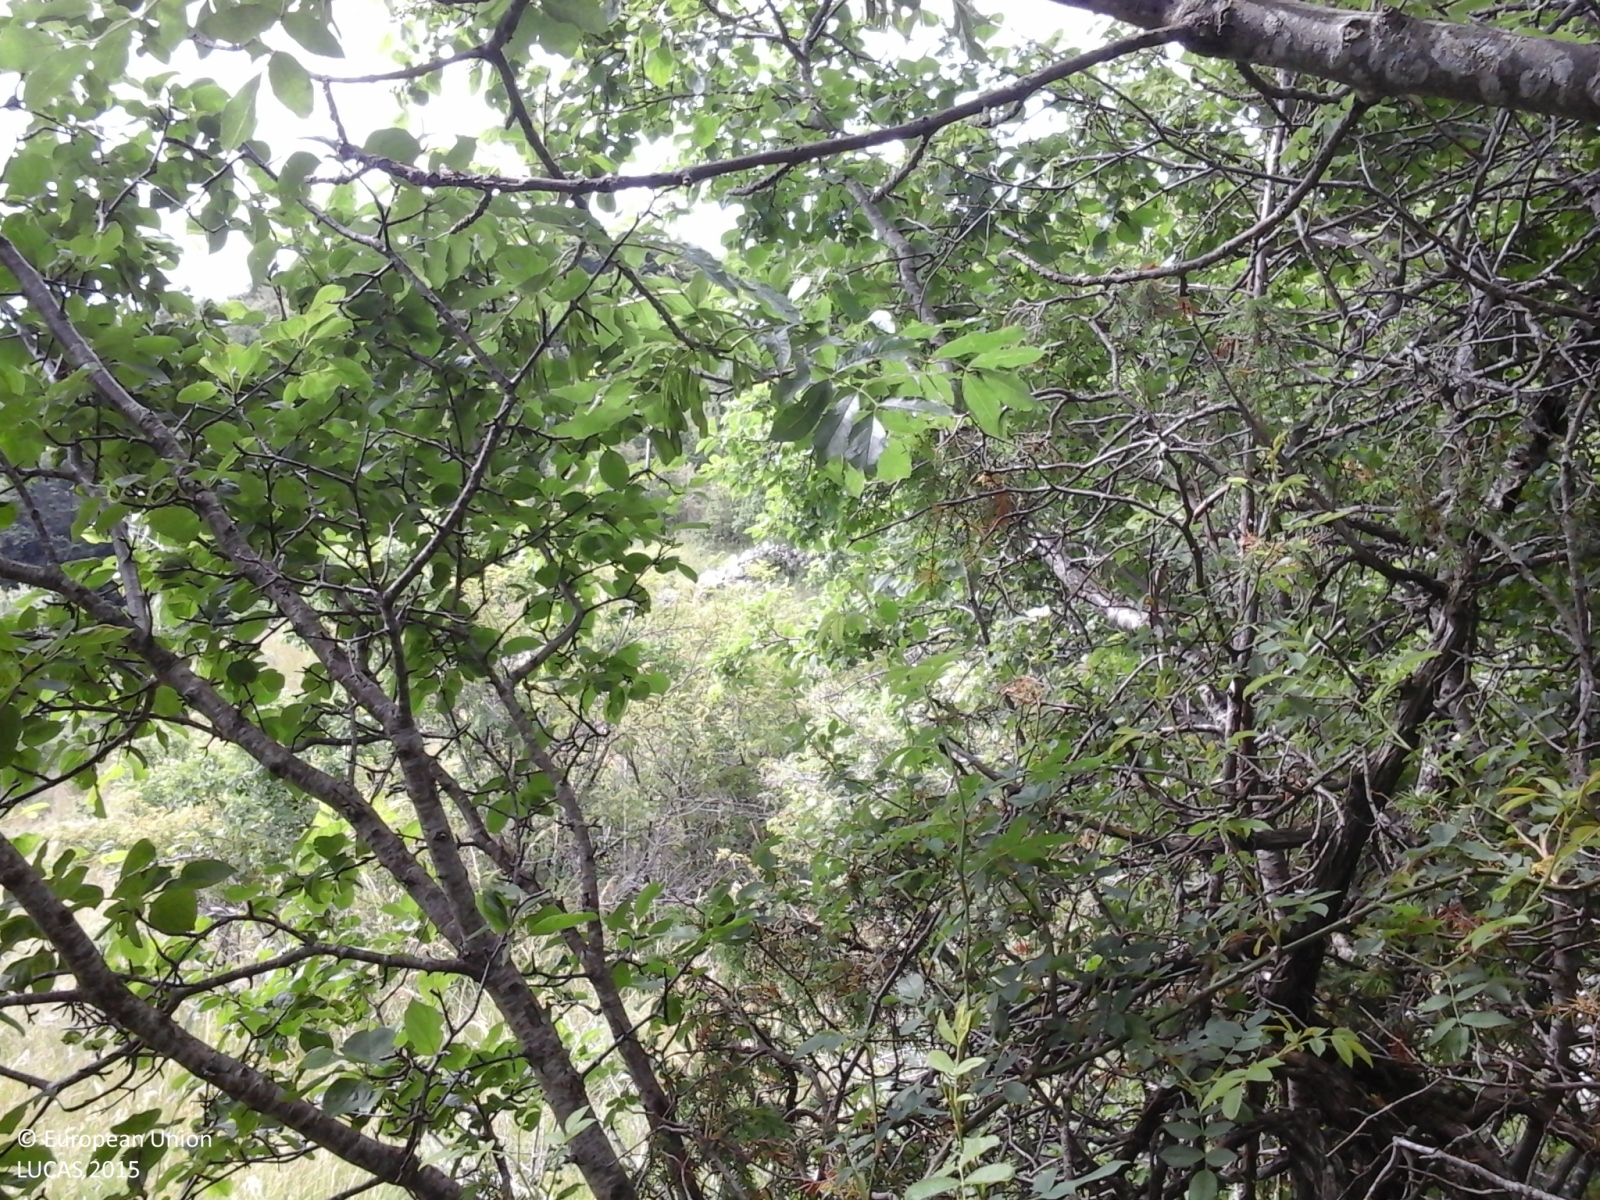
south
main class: Woodland
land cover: Broadleaved woodland
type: mesophytic deciduous forest
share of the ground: > 75 %
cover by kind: broadleaved forest trees 100 %
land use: Semi-natural and natural areas not in use
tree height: > 5 m
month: June
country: IT
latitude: 46.0177
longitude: 12.4123
